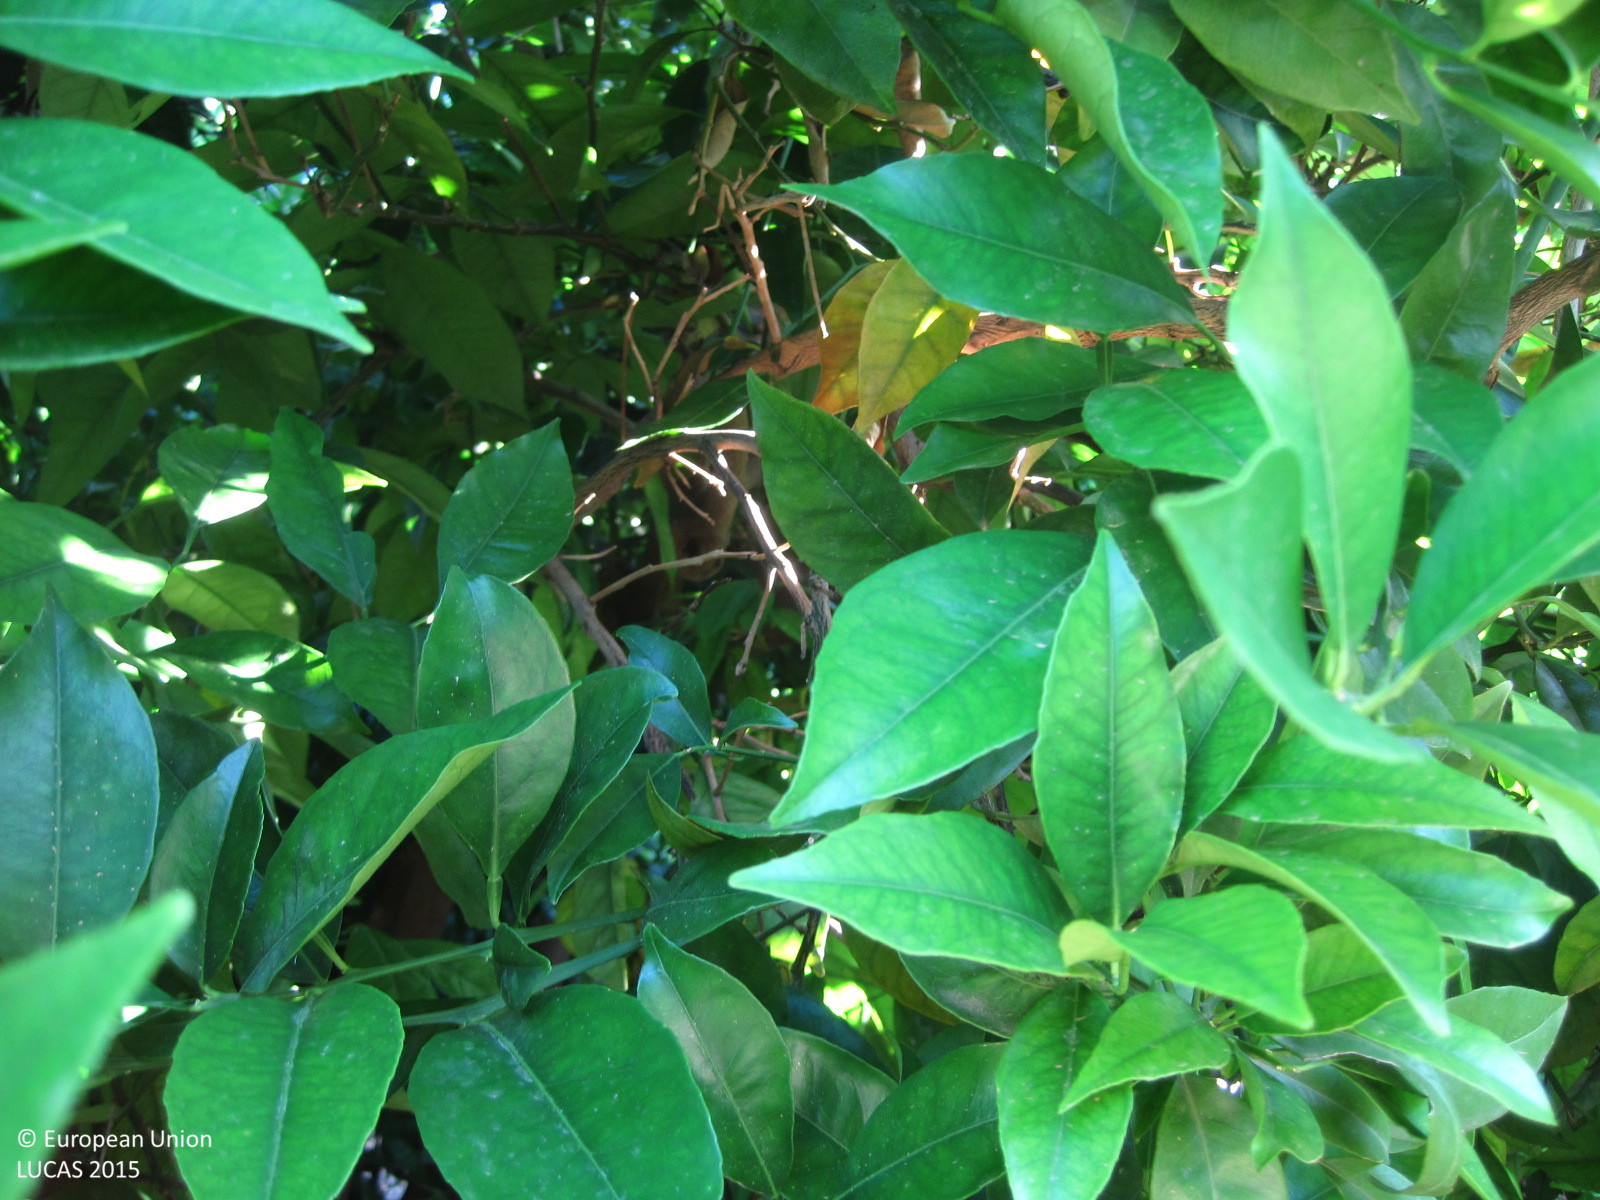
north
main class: Cropland
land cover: Oranges
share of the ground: > 75 %
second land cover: Other bare soil
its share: > 75 %
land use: Agriculture (excluding fallow land and kitchen gardens)
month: May
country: ES
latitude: 39.7171
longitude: -0.6986
